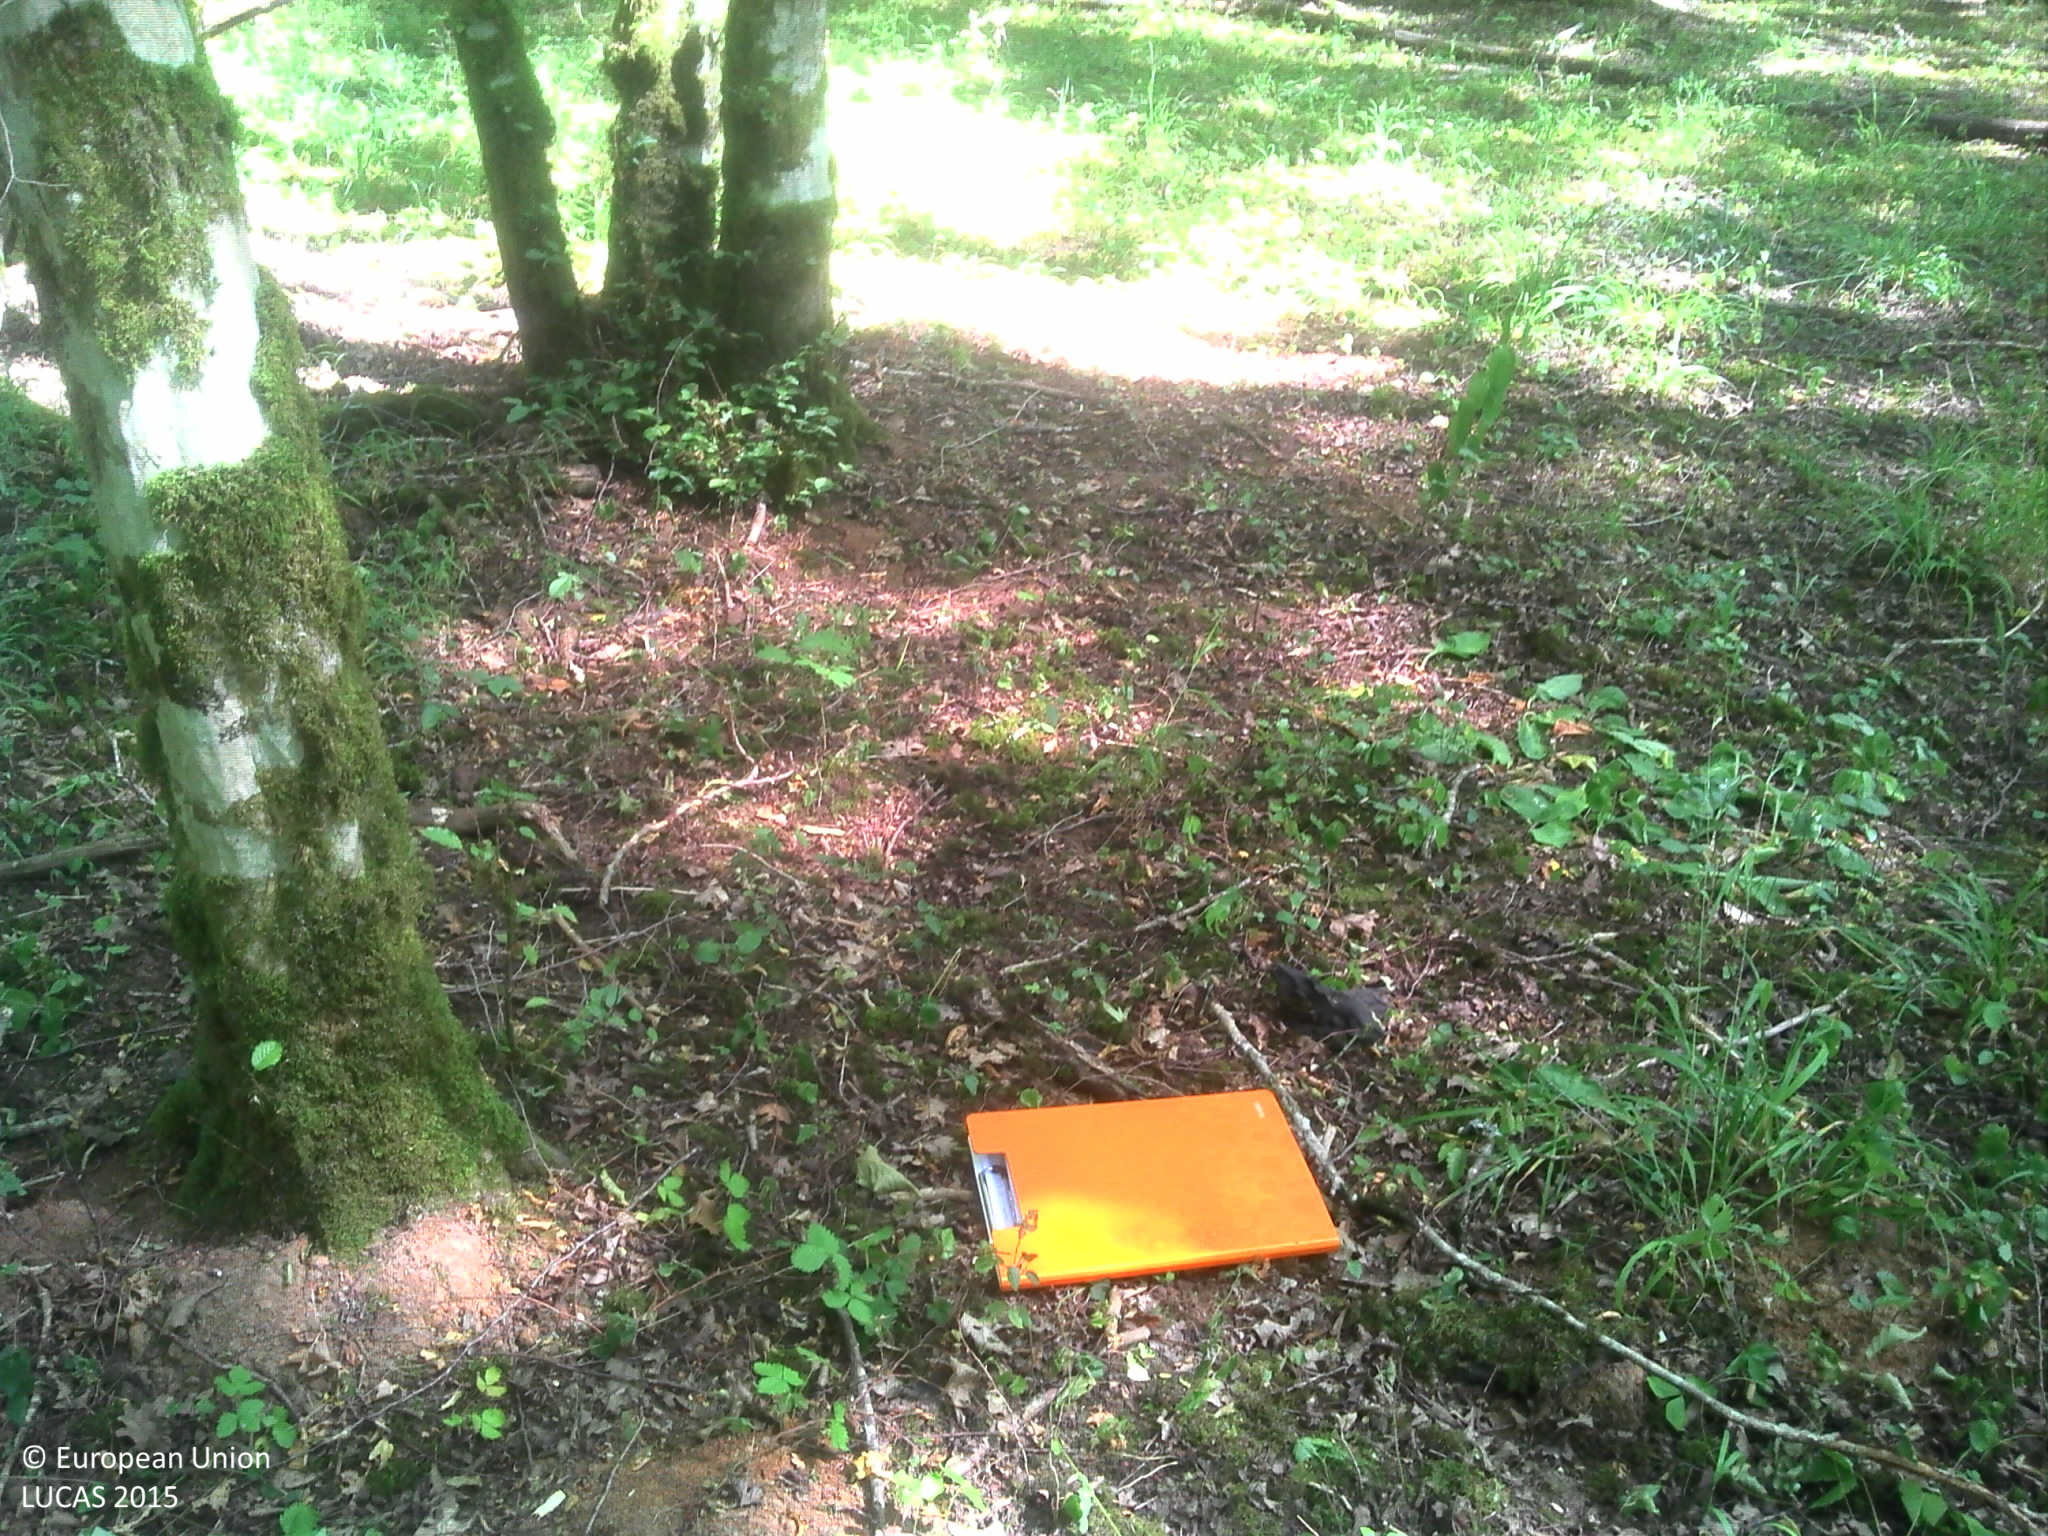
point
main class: Woodland
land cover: Broadleaved woodland
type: beech forest
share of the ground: > 75 %
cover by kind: broadleaved forest trees 80 %, herbaceous plants 10 %, lichens and mosses 10 %
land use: Forestry
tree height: > 5 m
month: July
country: FR
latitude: 48.0174
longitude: 4.9445
